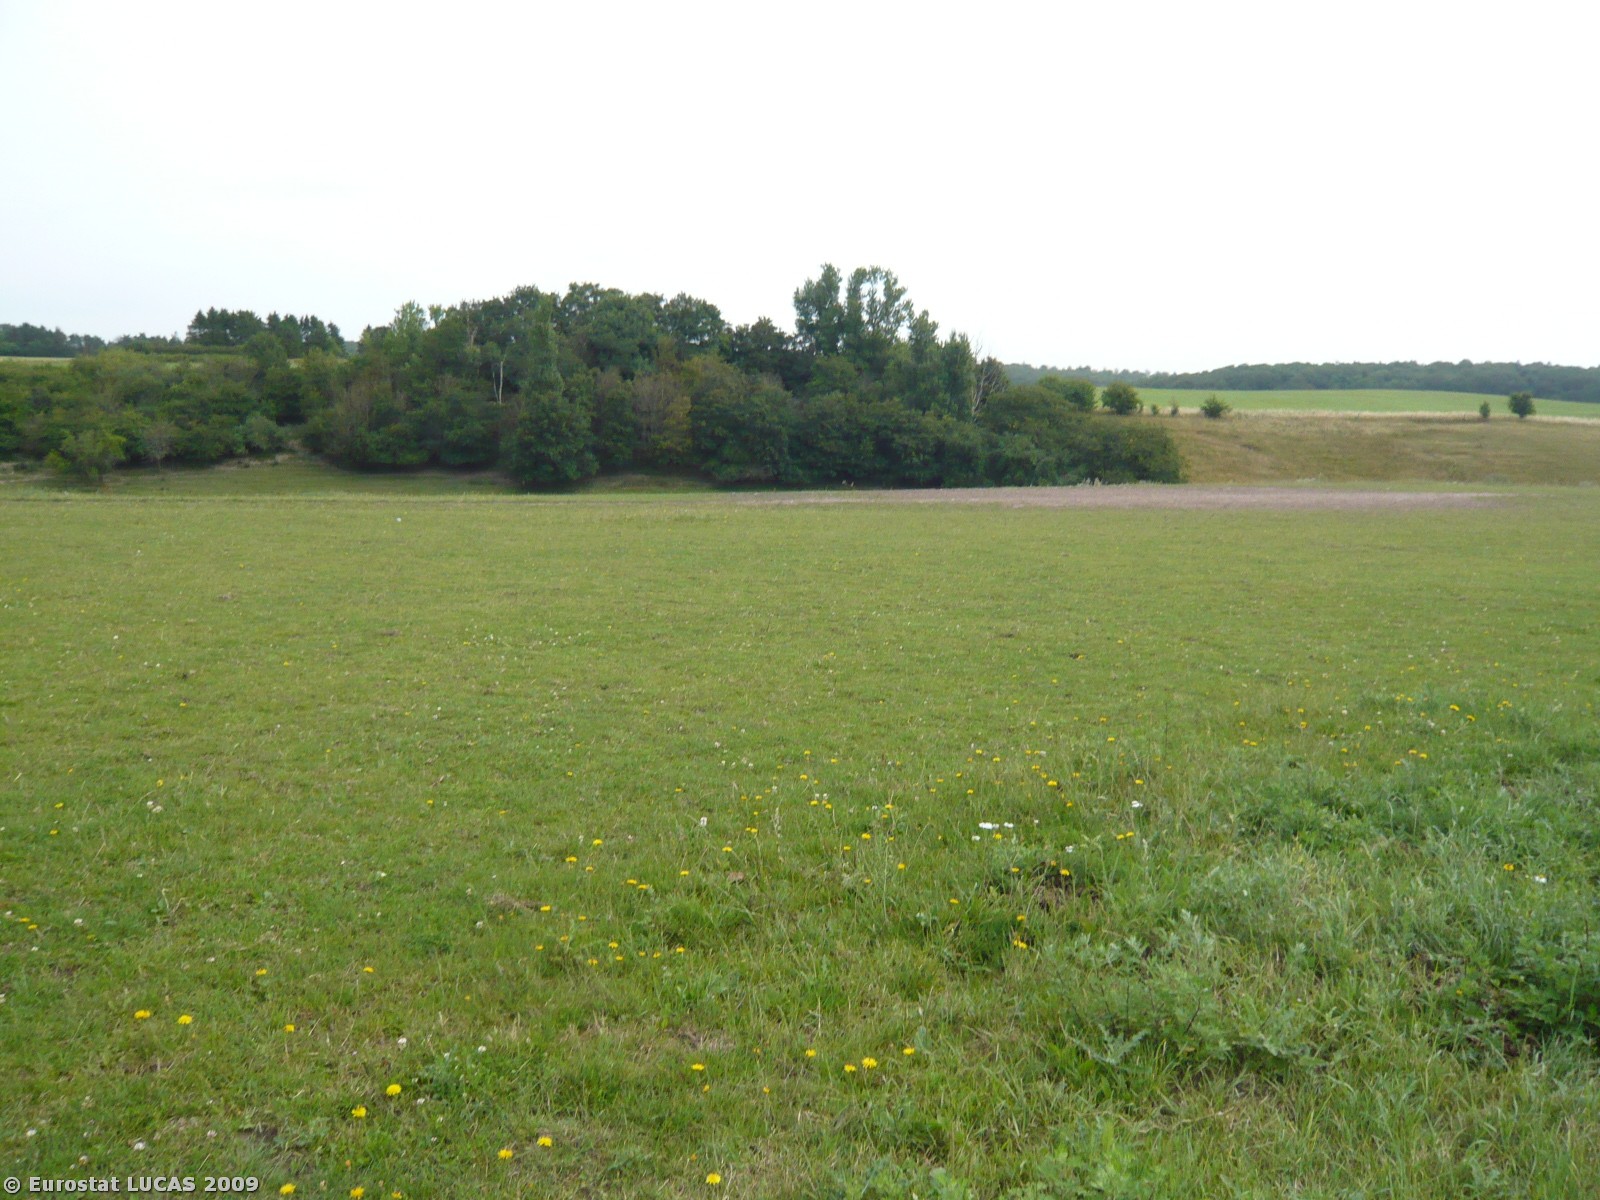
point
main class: Grassland
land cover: Grassland without tree/shrub cover
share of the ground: > 75 %
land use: Agriculture (excluding fallow land and kitchen gardens)
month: July
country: DK
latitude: 55.8095
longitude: 12.1841
